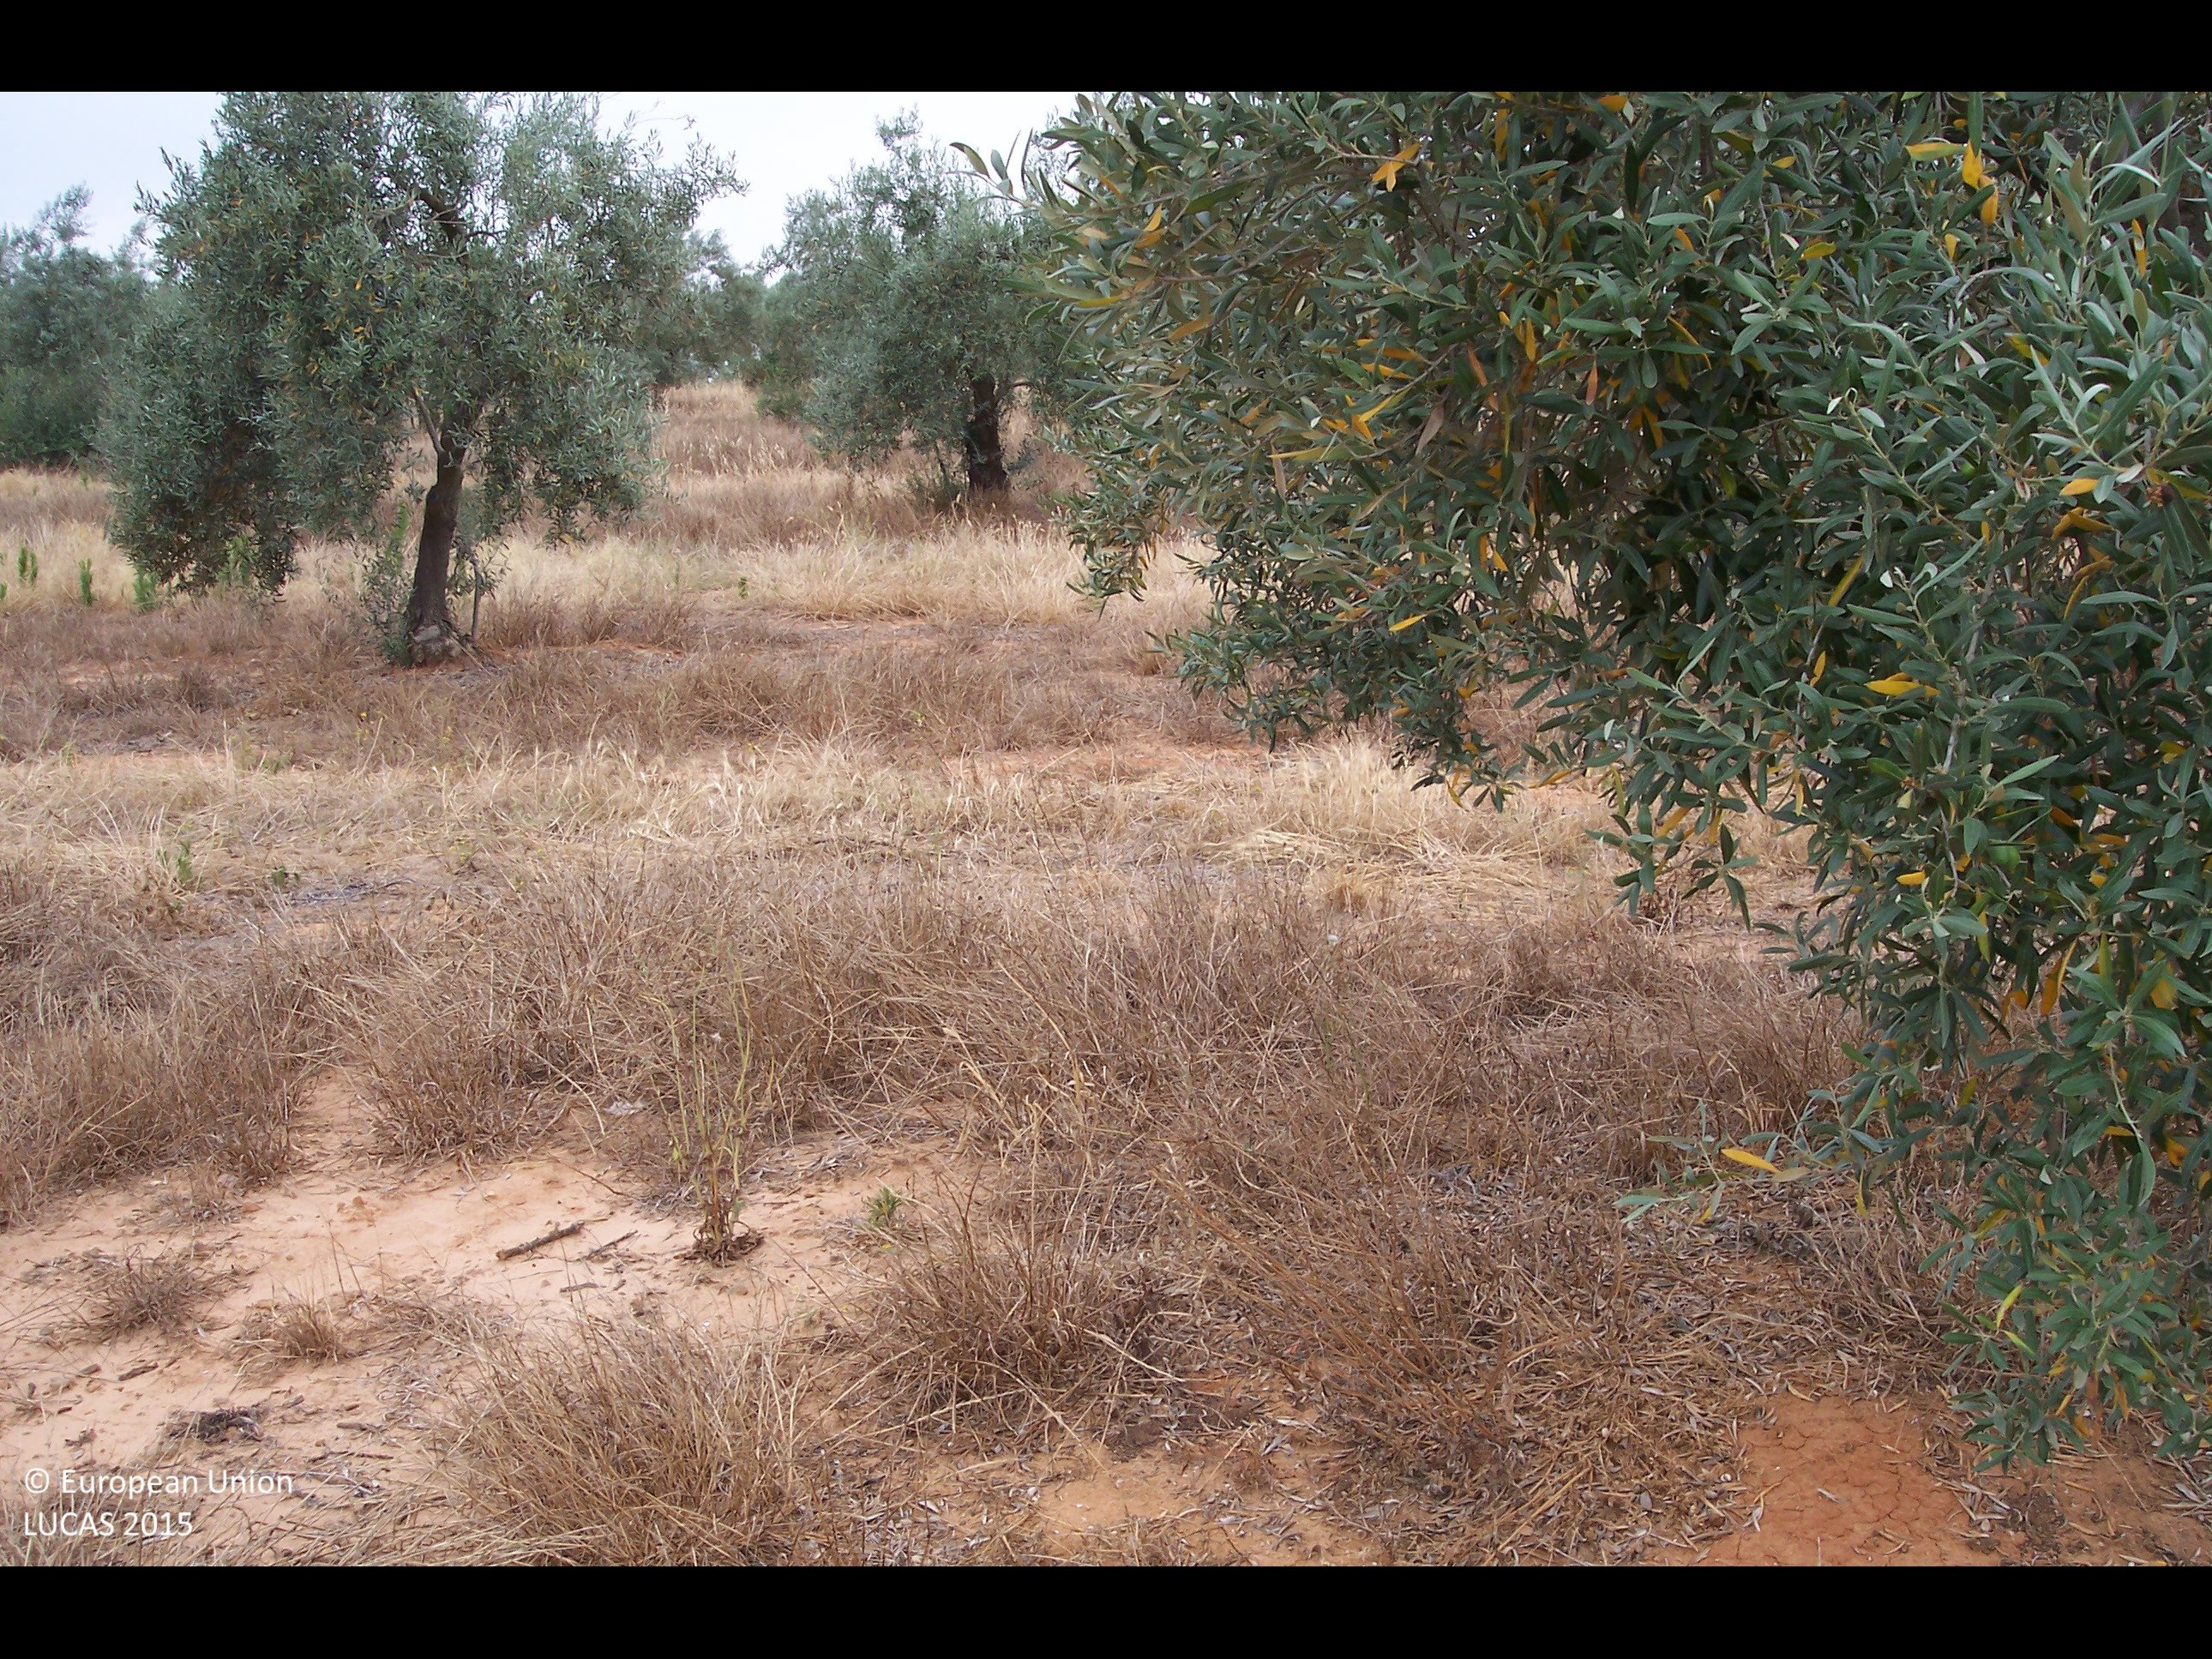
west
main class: Cropland
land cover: Olive groves
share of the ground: 25 - 50 %
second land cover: Spontaneously vegetated surfaces
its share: > 75 %
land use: Agriculture (excluding fallow land and kitchen gardens)
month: June
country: ES
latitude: 37.3025
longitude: -6.1234
